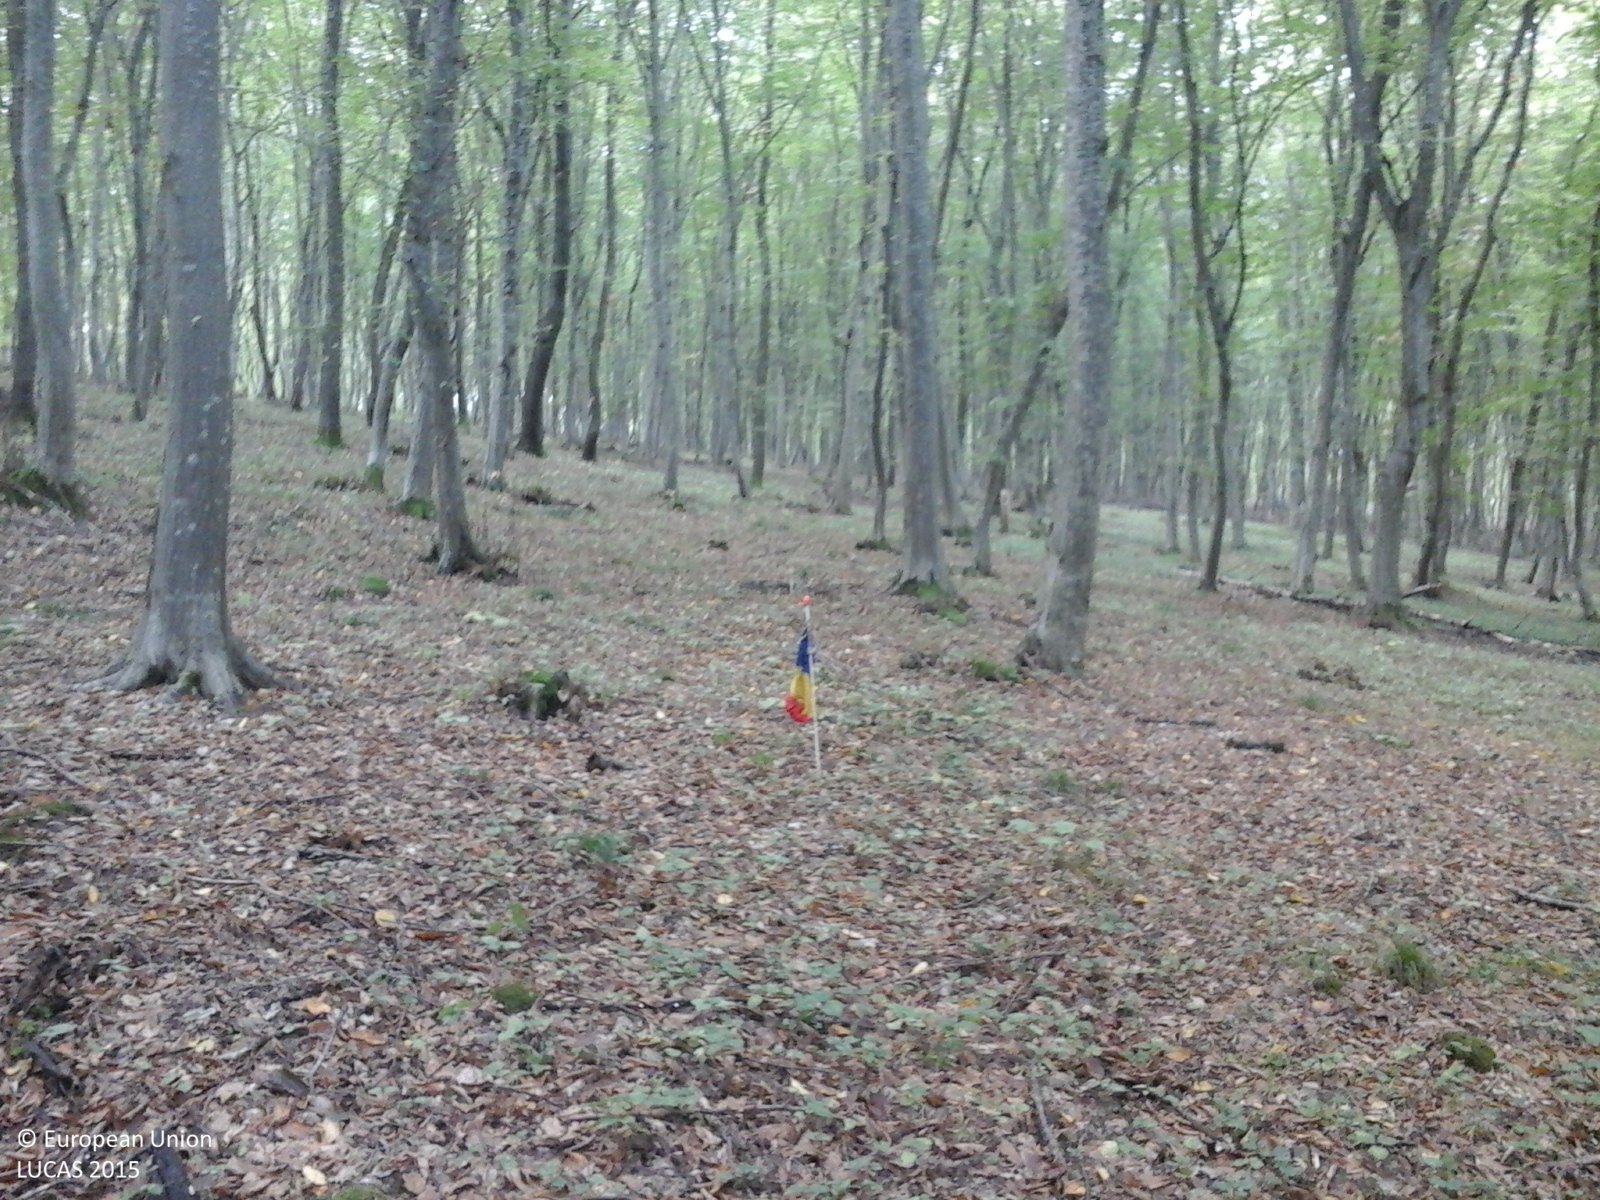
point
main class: Woodland
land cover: Broadleaved woodland
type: beech forest
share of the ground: > 75 %
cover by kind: broadleaved forest trees 100 %
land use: Forestry
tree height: > 5 m
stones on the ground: < 10 %
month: October
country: RO
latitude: 46.6548
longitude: 24.7681
